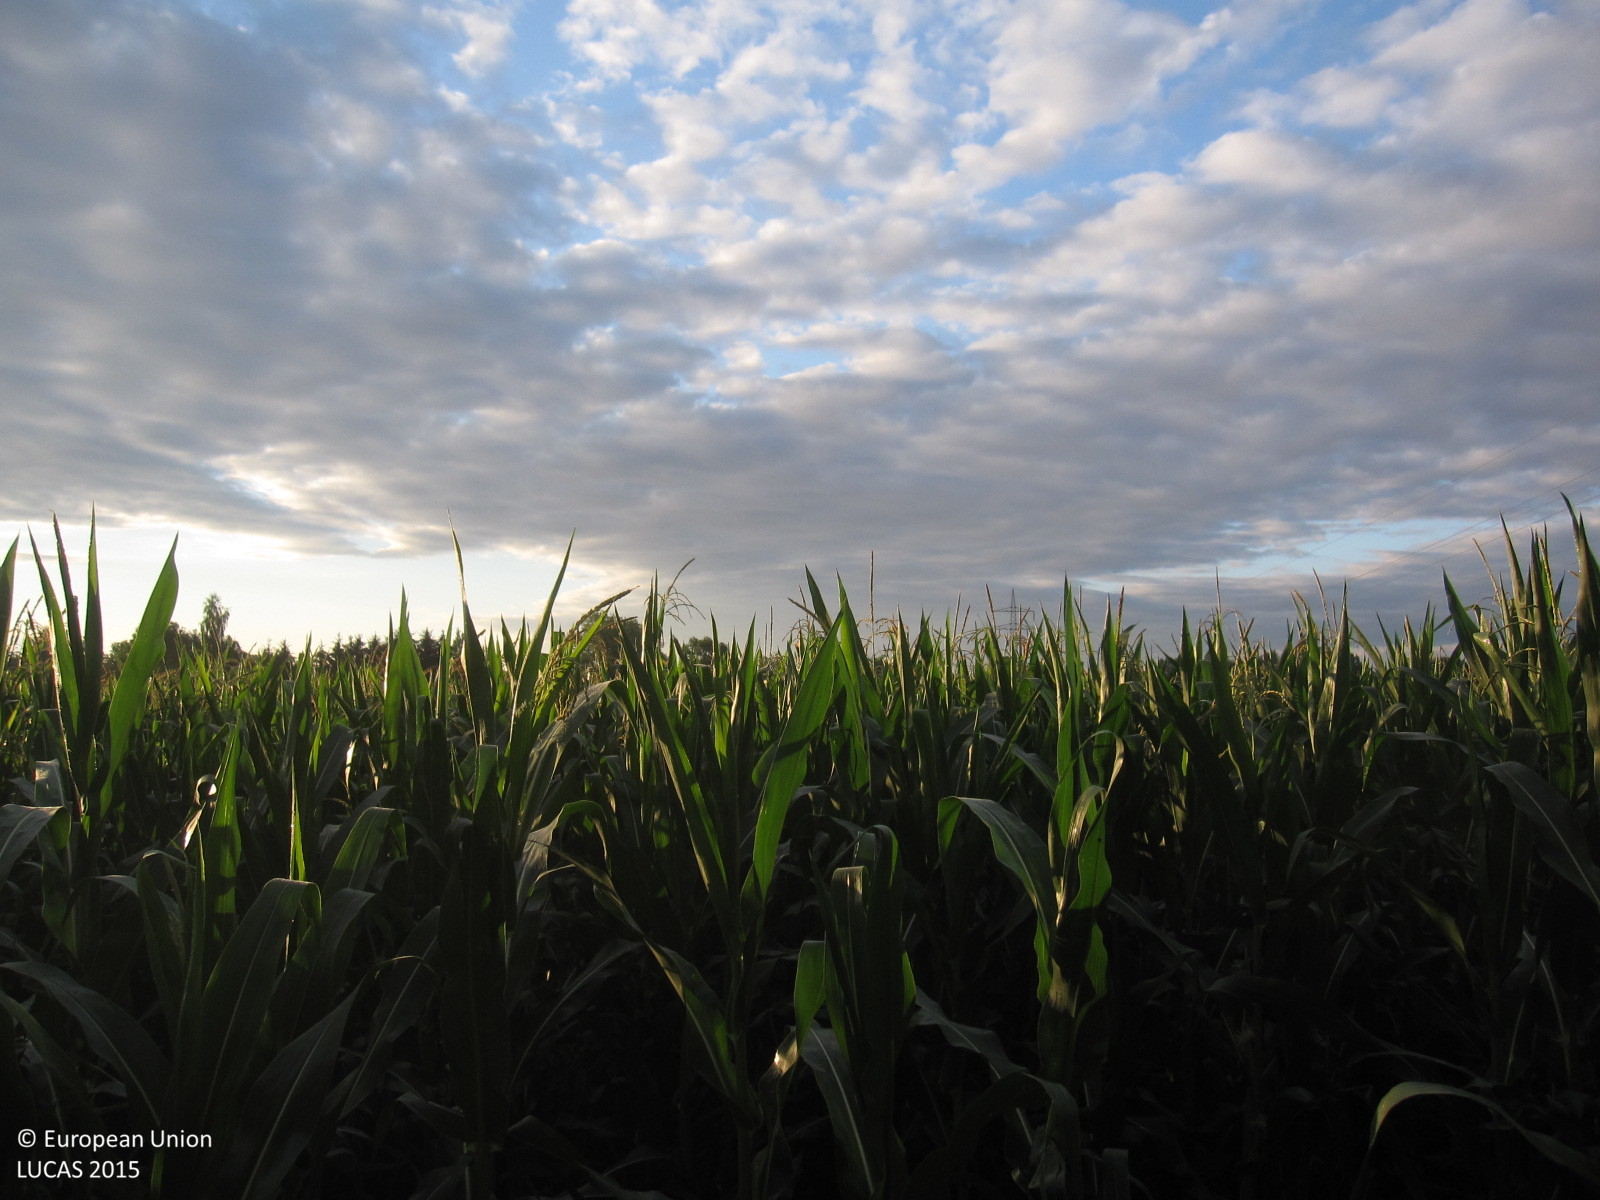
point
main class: Cropland
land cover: Maize
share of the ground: > 75 %
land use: Agriculture (excluding fallow land and kitchen gardens)
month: July
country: DE
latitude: 51.0807
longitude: 12.1837
